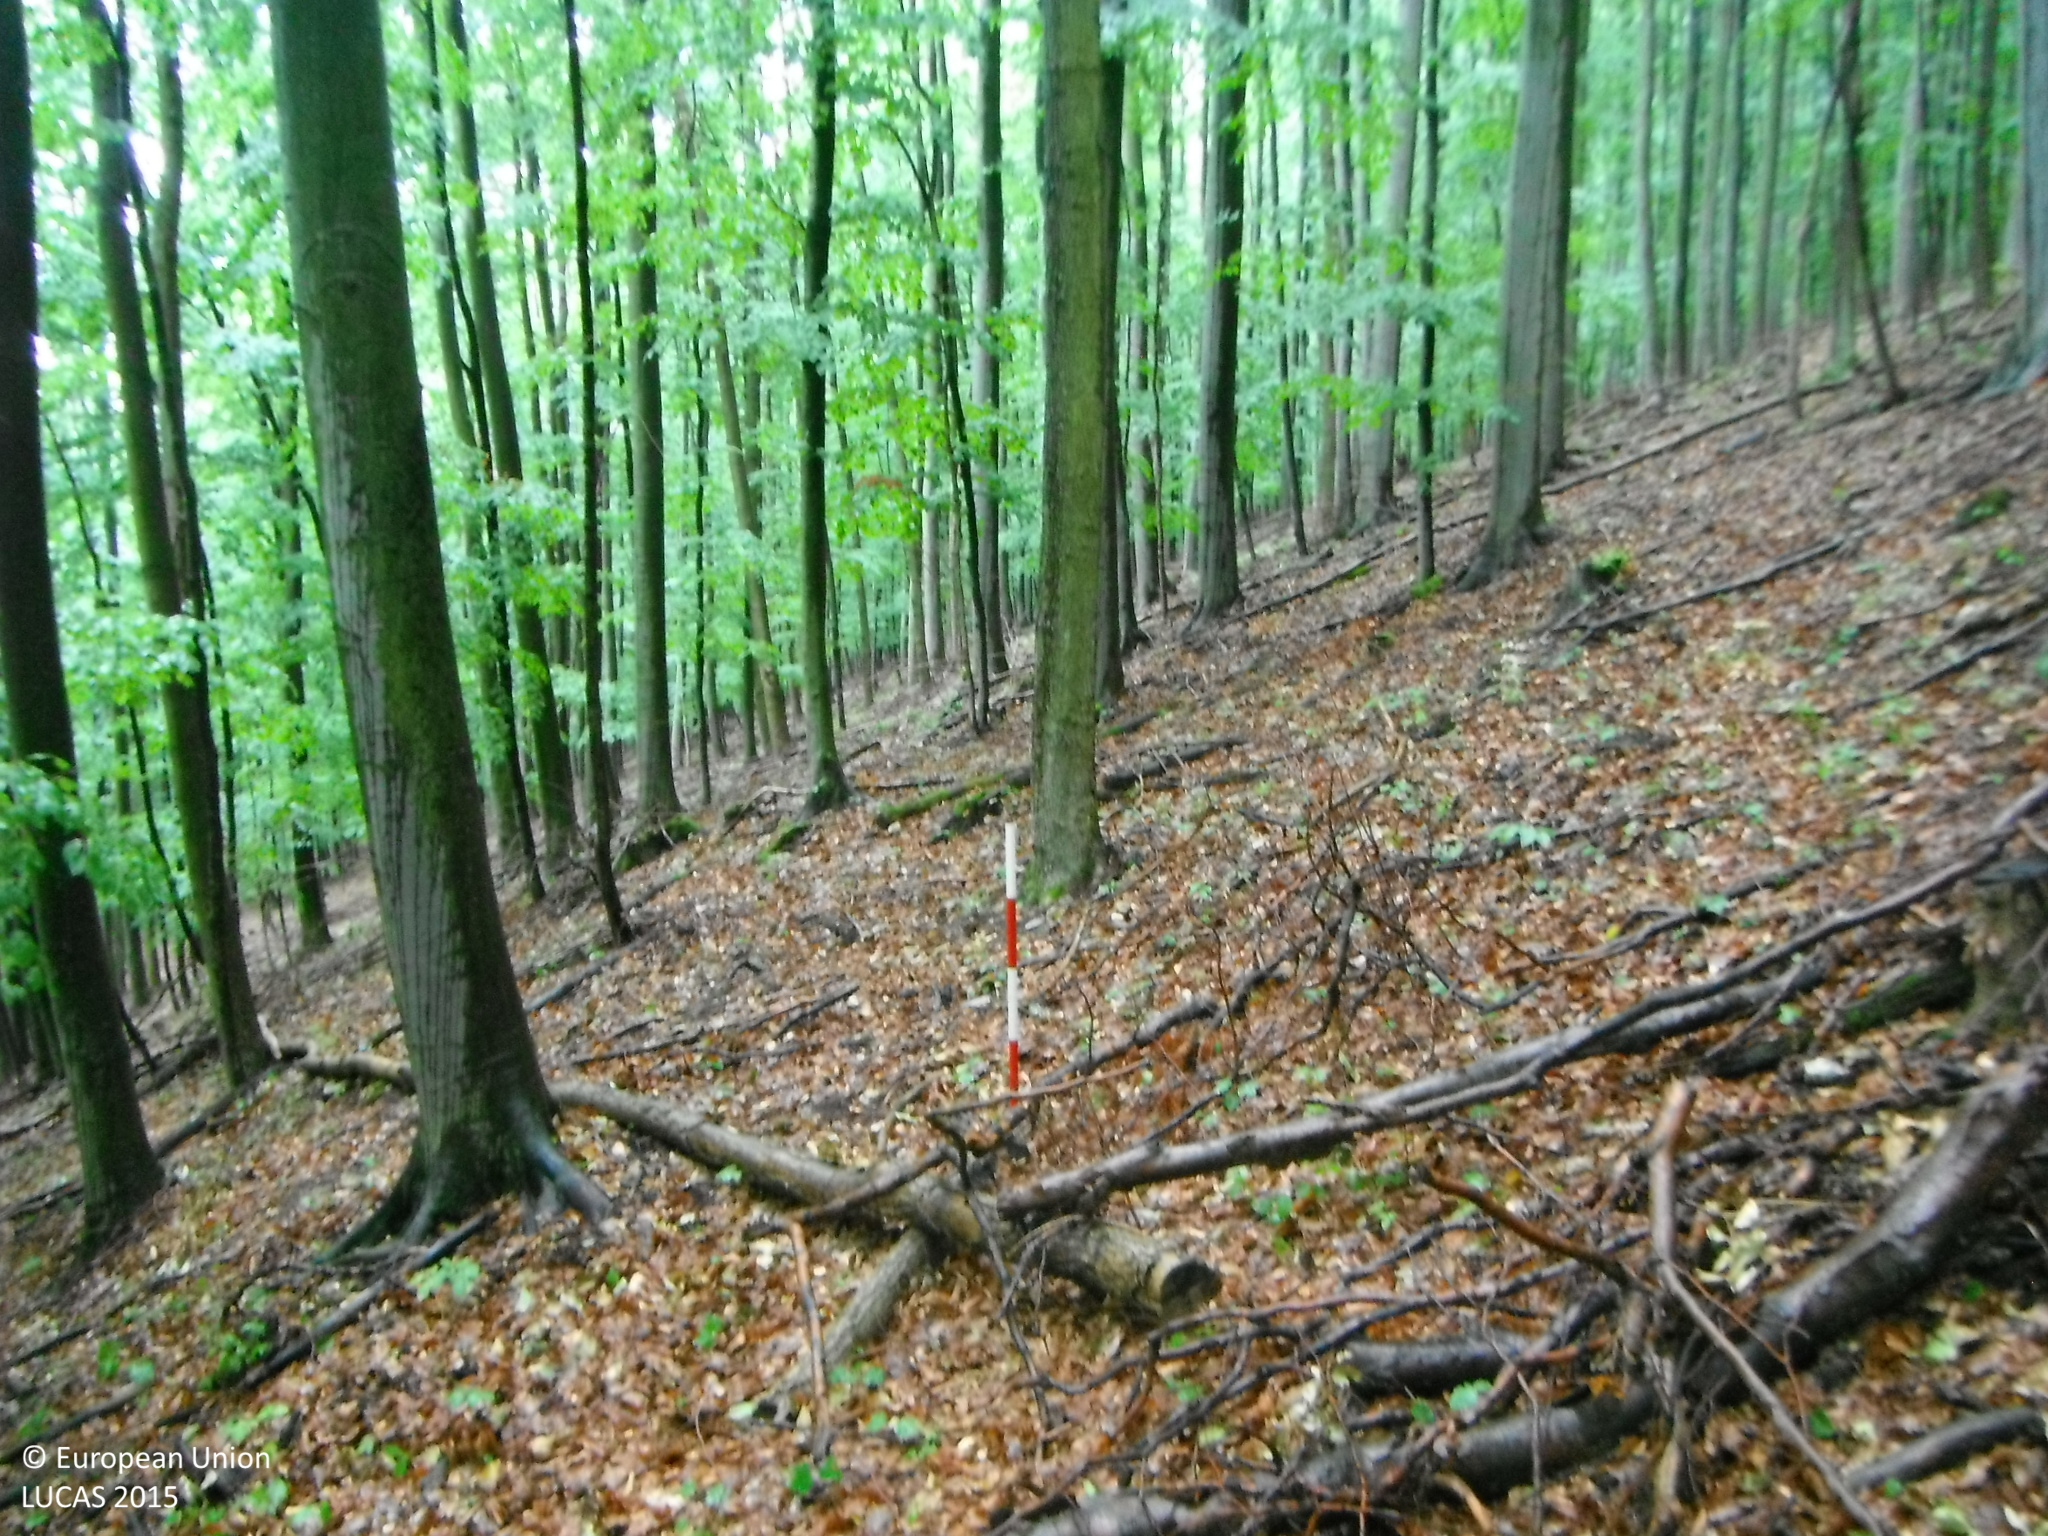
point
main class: Woodland
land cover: Broadleaved woodland
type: beech forest
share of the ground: > 75 %
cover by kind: broadleaved forest trees 100 %
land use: Forestry
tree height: > 5 m
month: July
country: SK
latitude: 48.7820
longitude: 18.0028
